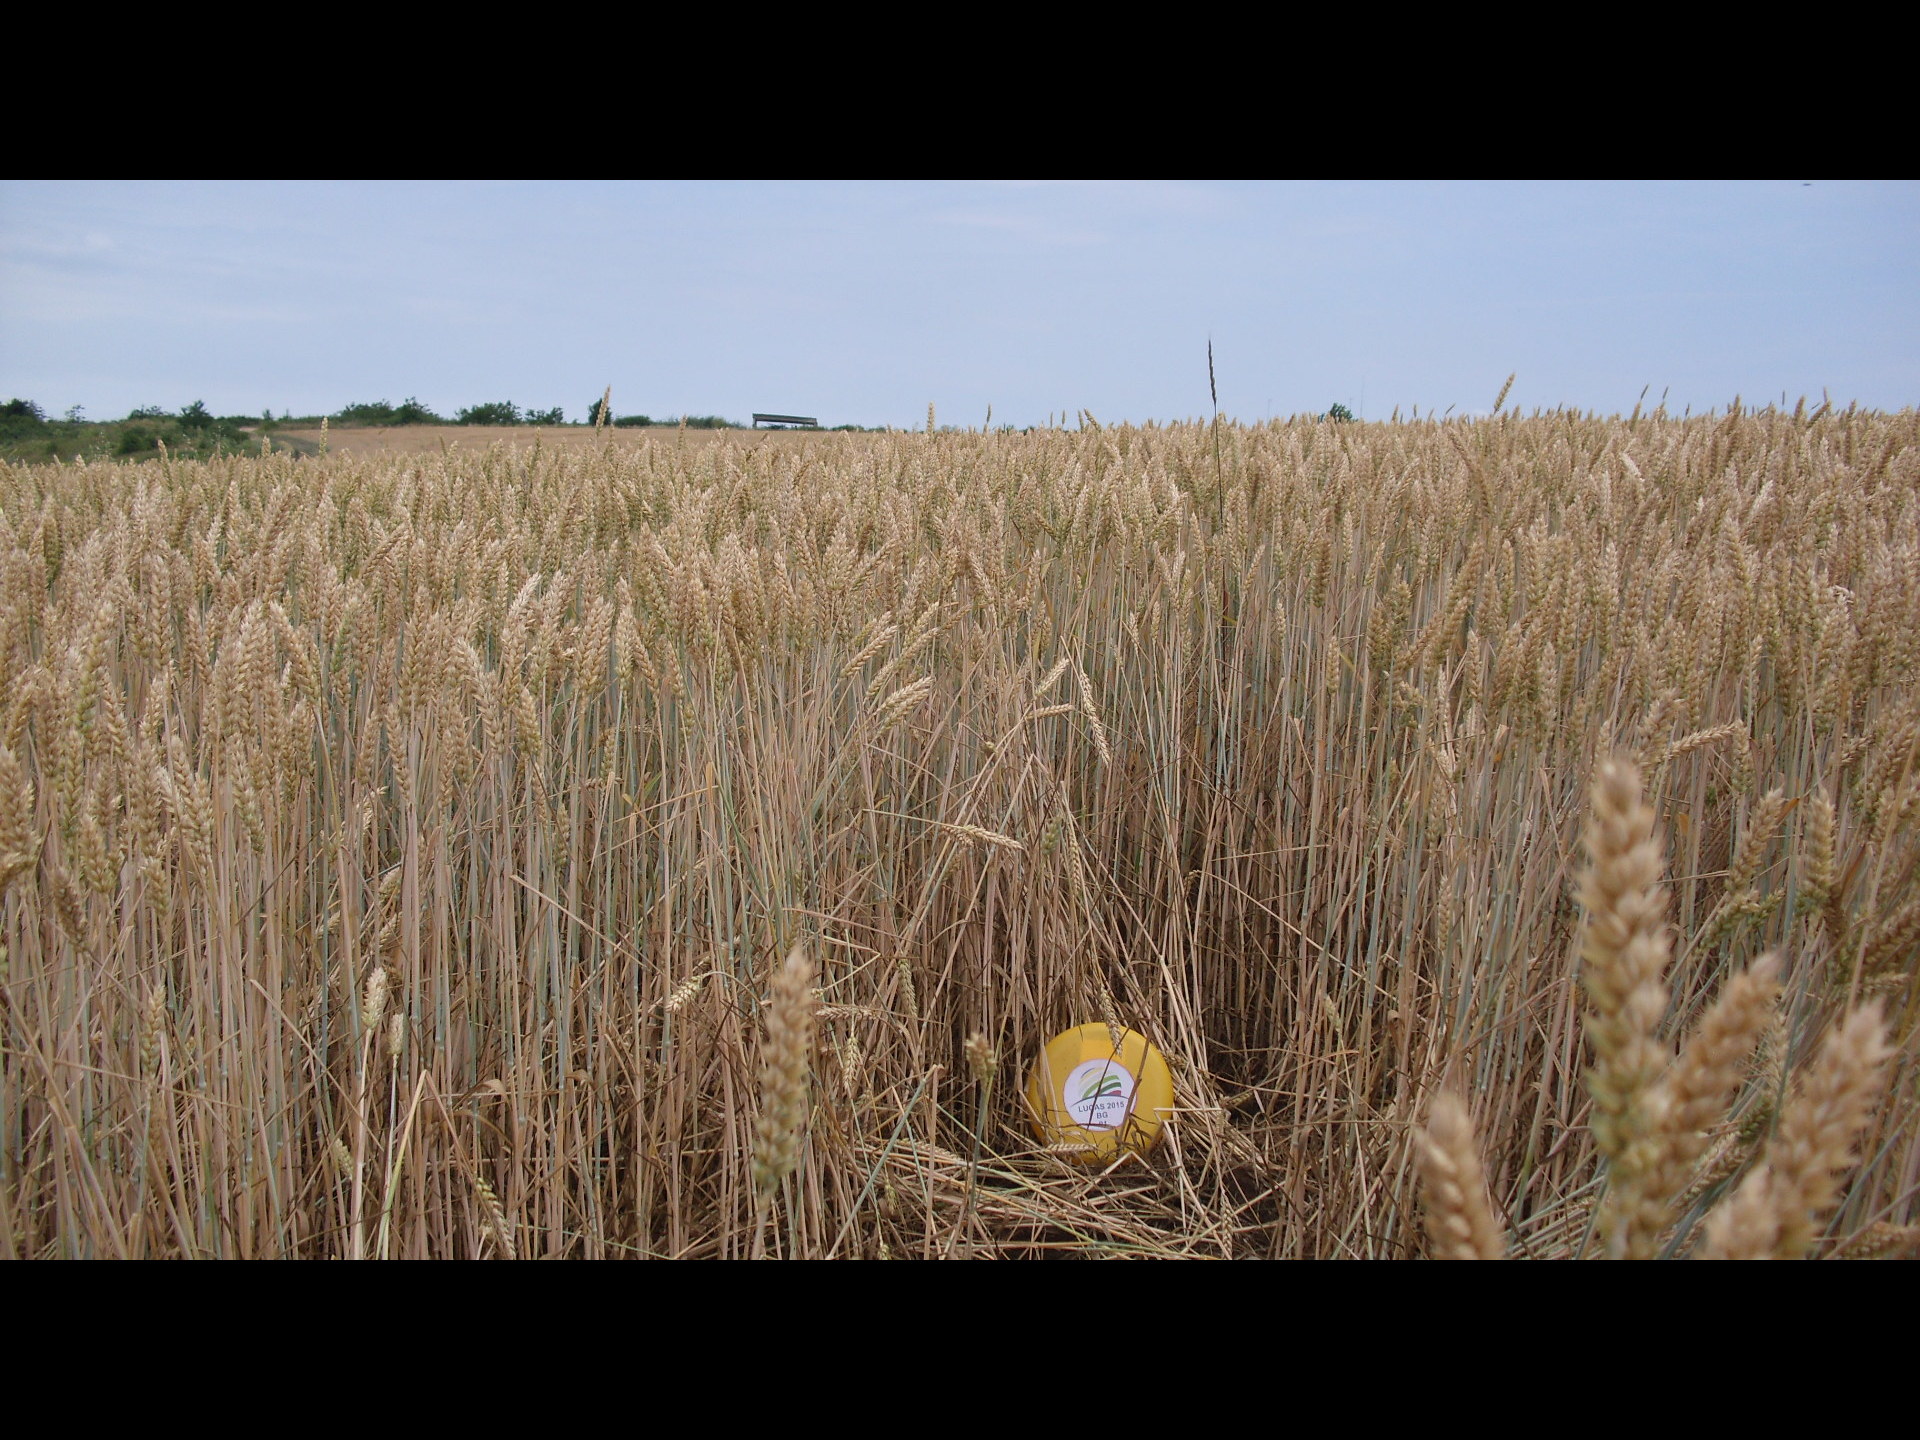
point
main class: Cropland
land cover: Common wheat
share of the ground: > 75 %
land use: Agriculture (excluding fallow land and kitchen gardens)
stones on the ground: < 10 %
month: June
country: BG
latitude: 43.3713
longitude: 23.5079
